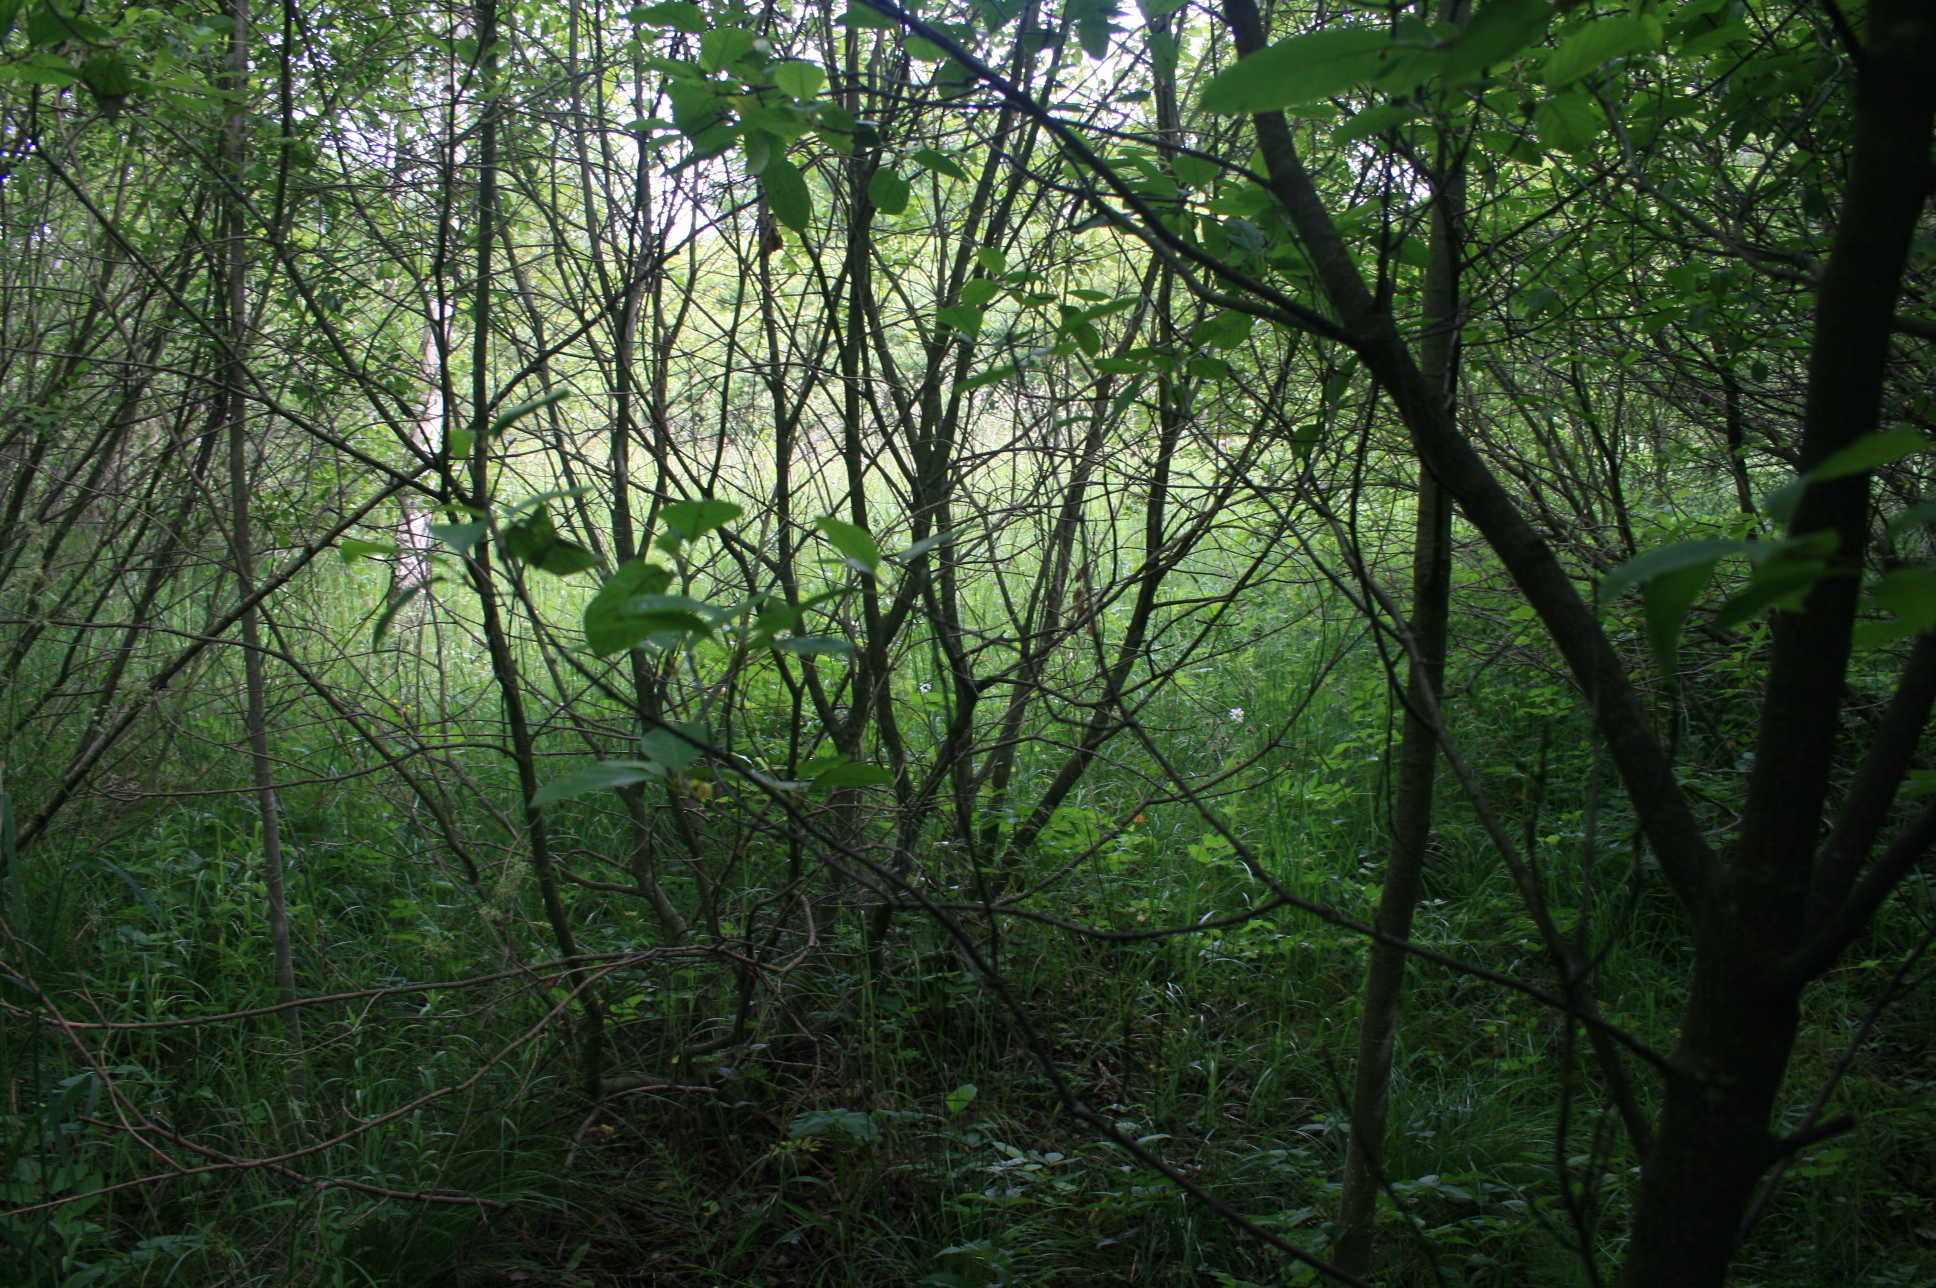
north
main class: Woodland
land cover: Broadleaved woodland
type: non-riverine alder, birch or aspen forest
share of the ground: > 75 %
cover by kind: broadleaved forest trees 95 %, herbaceous plants 5 %
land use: Forestry
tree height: > 5 m
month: June
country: LT
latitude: 55.2349
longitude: 22.0530
